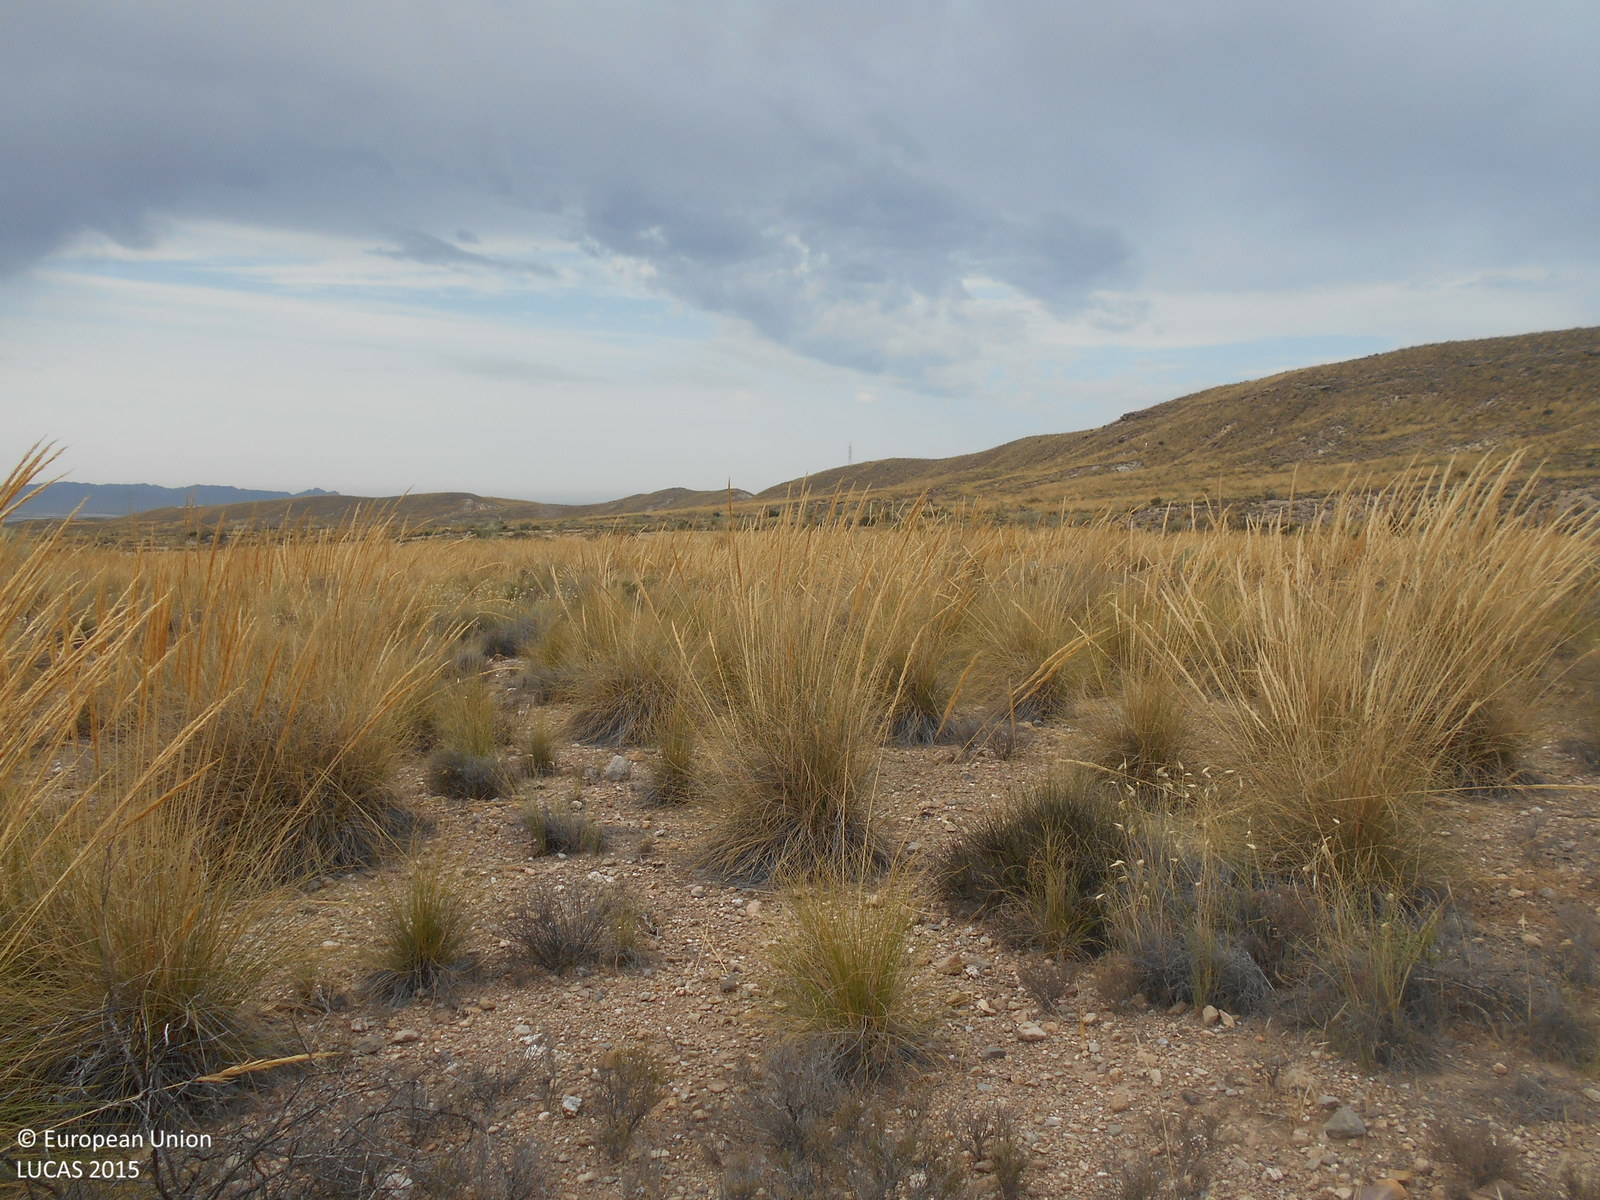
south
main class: Shrubland
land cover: Shrubland without tree cover
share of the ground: 25 - 50 %
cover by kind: shrubs 40 %, unconsolidated bare surface 40 %, herbaceous plants 20 %
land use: Semi-natural and natural areas not in use
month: May
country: ES
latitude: 36.9315
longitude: -2.2689
